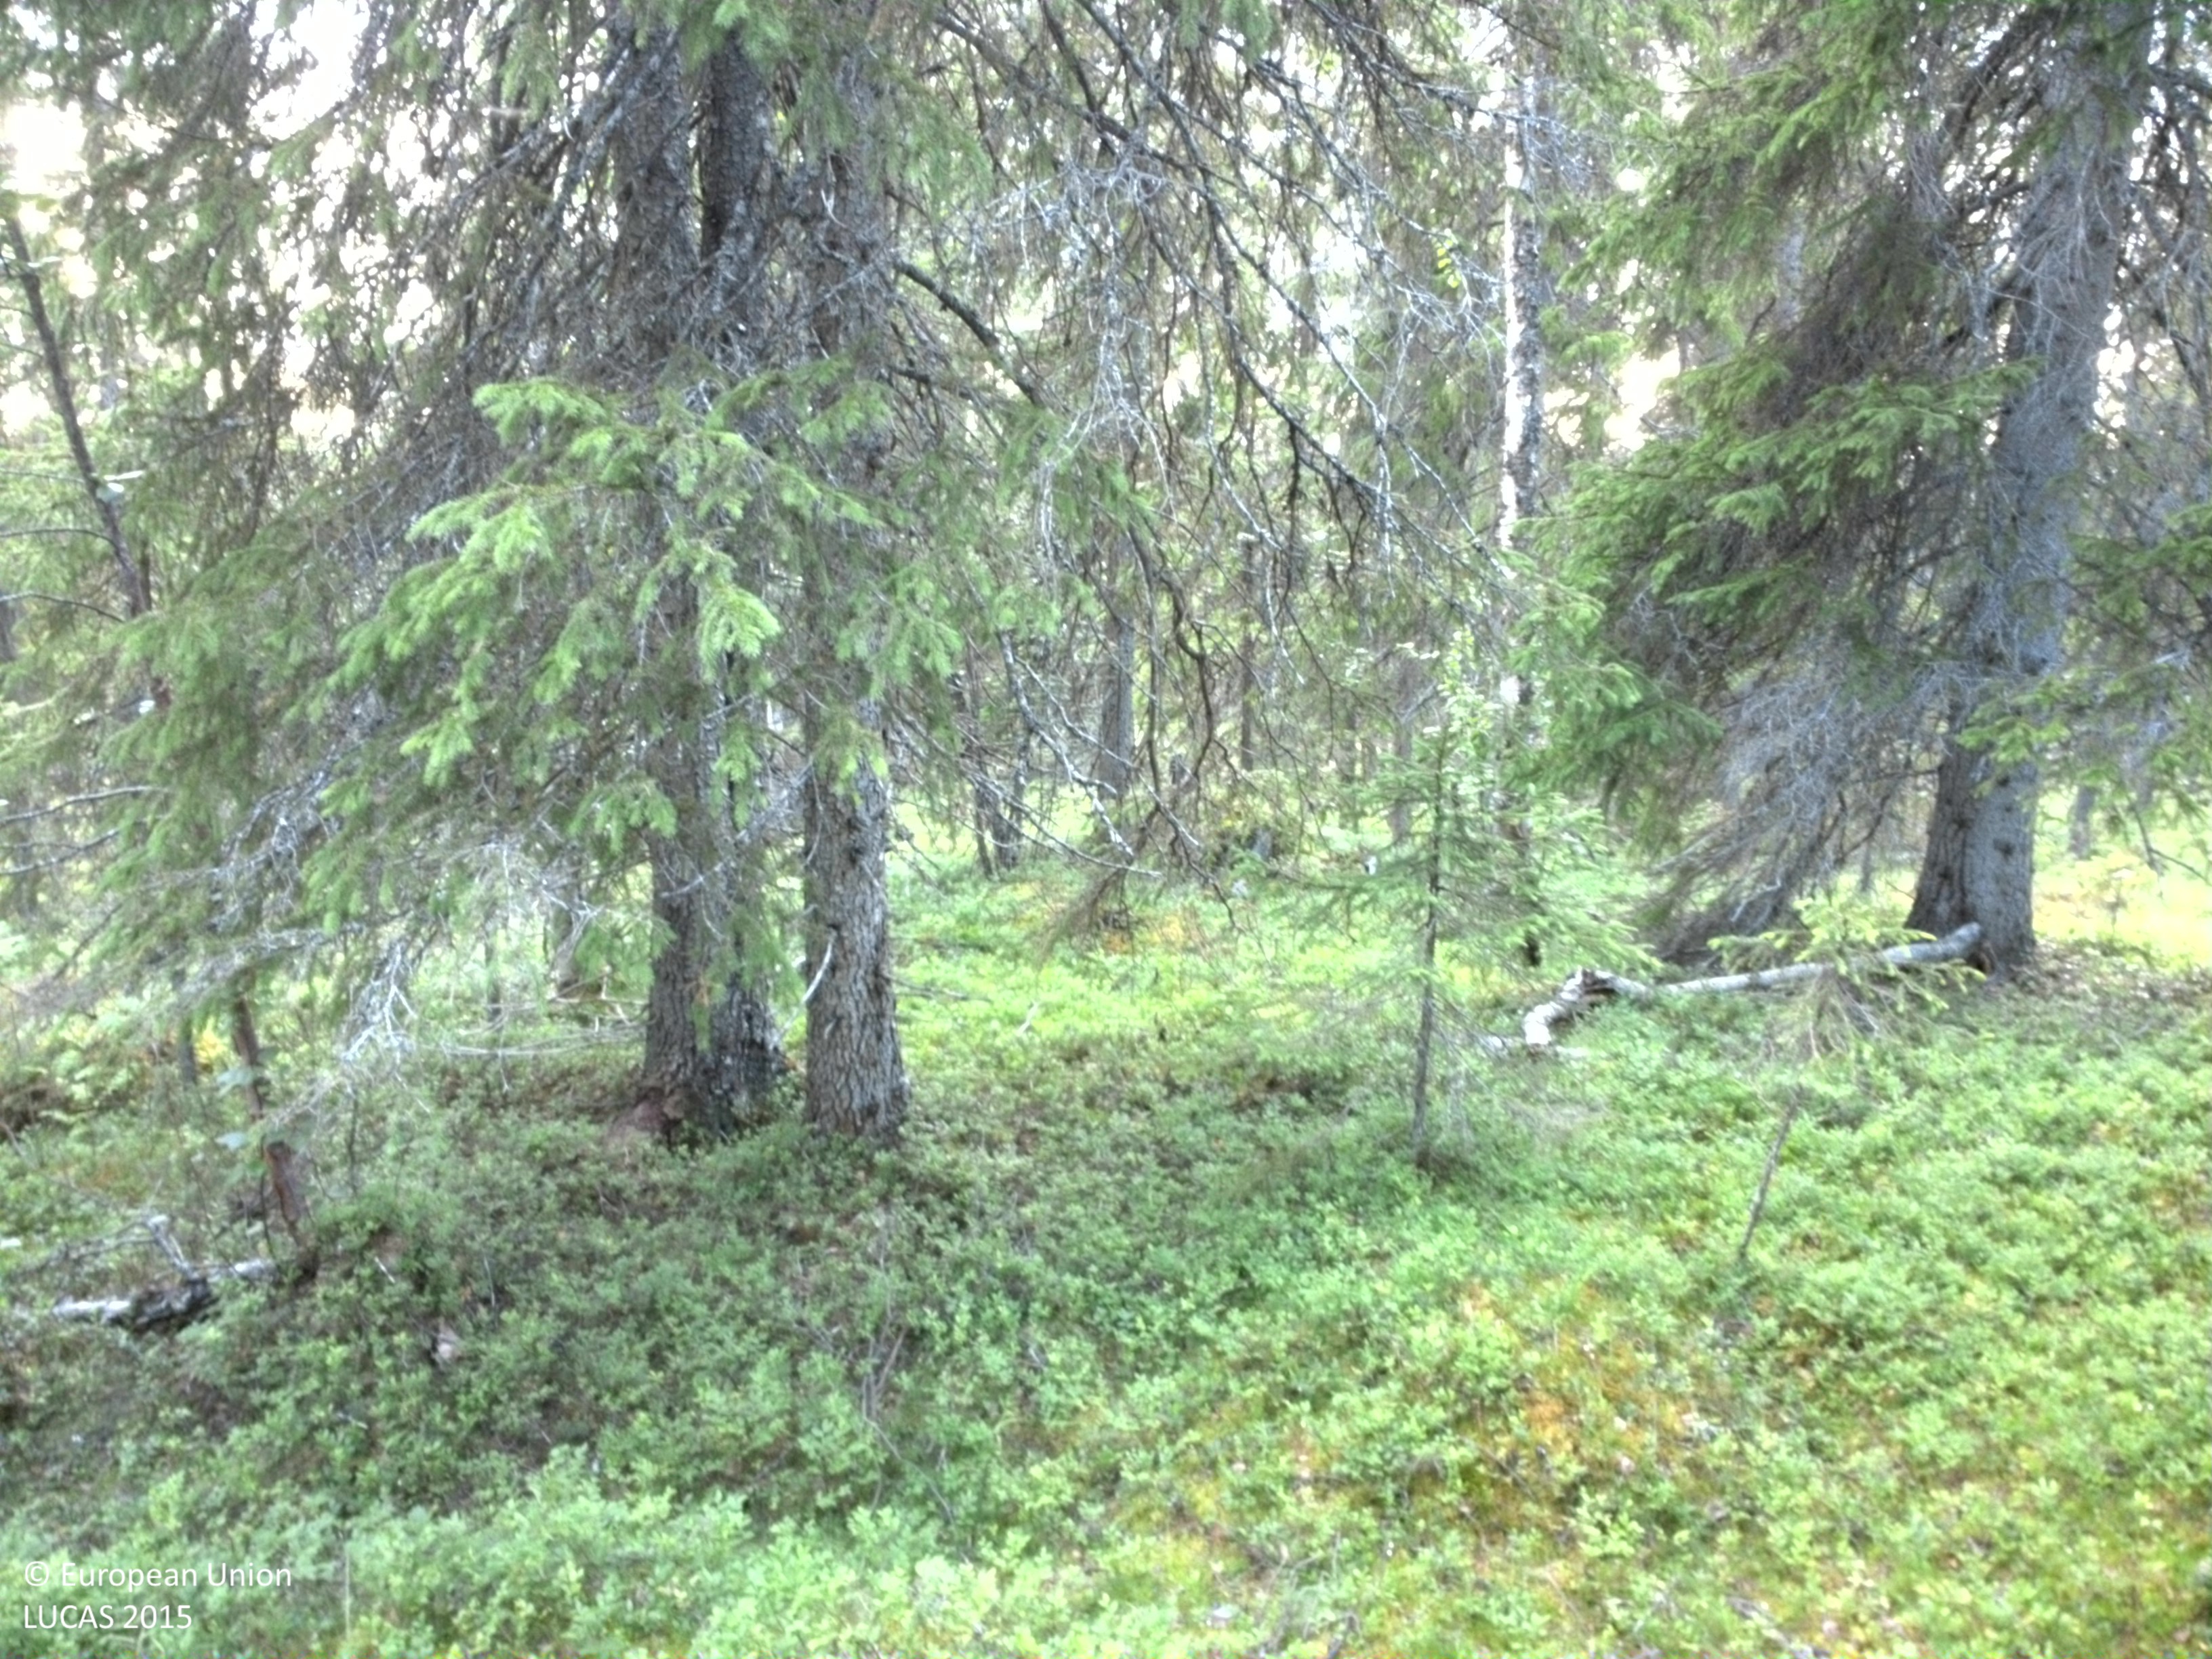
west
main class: Woodland
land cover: Spruce dominated coniferous woodland
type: boreal forest
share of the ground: 50 - 75 %
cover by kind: coniferous forest trees 40 %, shrubs 35 %, broadleaved forest trees 10 %, lichens and mosses 10 %, herbaceous plants 5 %
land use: Forestry
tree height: > 5 m
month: August
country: SE
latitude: 65.0481
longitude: 15.9356
